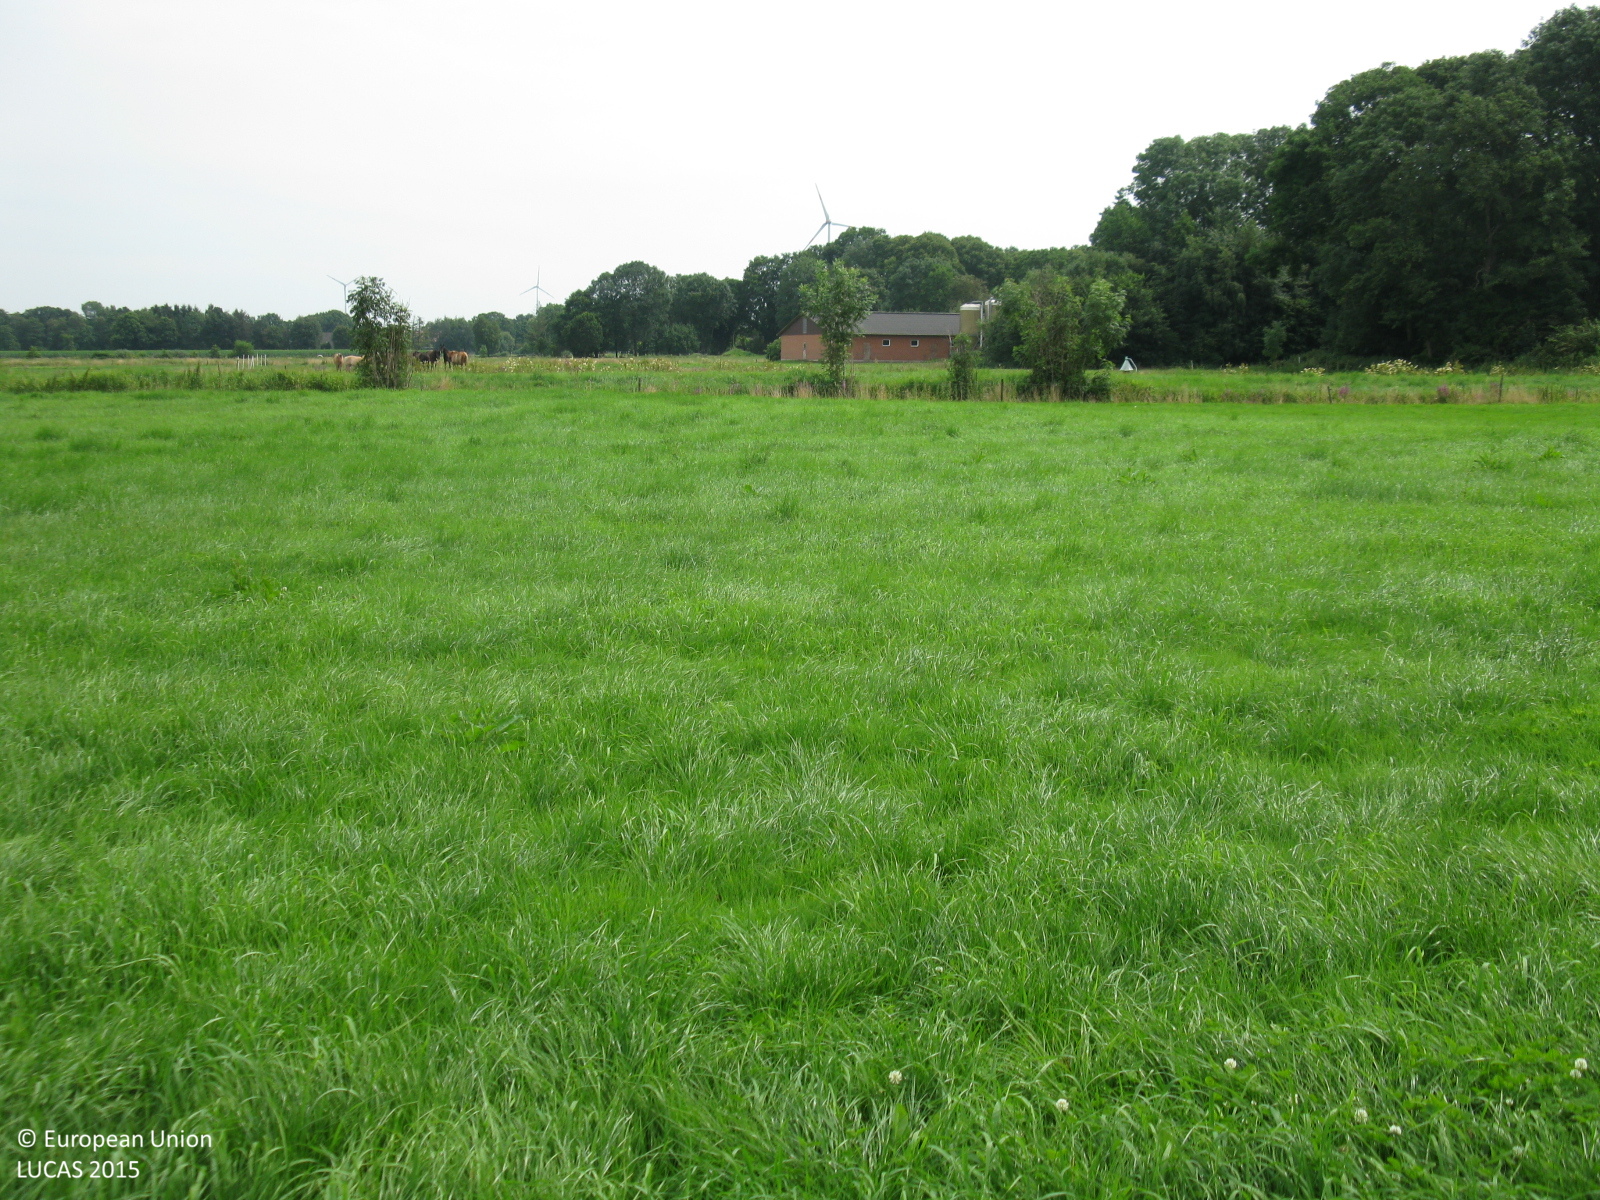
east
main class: Grassland
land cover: Grassland without tree/shrub cover
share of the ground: > 75 %
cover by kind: herbaceous plants 100 %
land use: Agriculture (excluding fallow land and kitchen gardens)
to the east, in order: Grassland without tree/shrub cover; Fences; Ditches and canals; Broadleaved woodland; Grassland without tree/shrub cover; Paved roads, cycling and walking lanes; Grass margins; Ditches and canals; Fences; Grassland without tree/shrub cover; Fences; Ditches and canals; Fences; Grassland without tree/shrub cover; Fences; Ditches and canals; Fences; Grassland without tree/shrub cover; Artificial constructions in urban areas; Broadleaved woodland; Grass margins; Inland fresh running water; Fences; Grassland without tree/shrub cover
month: August
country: DE
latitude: 53.1389
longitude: 8.3413
